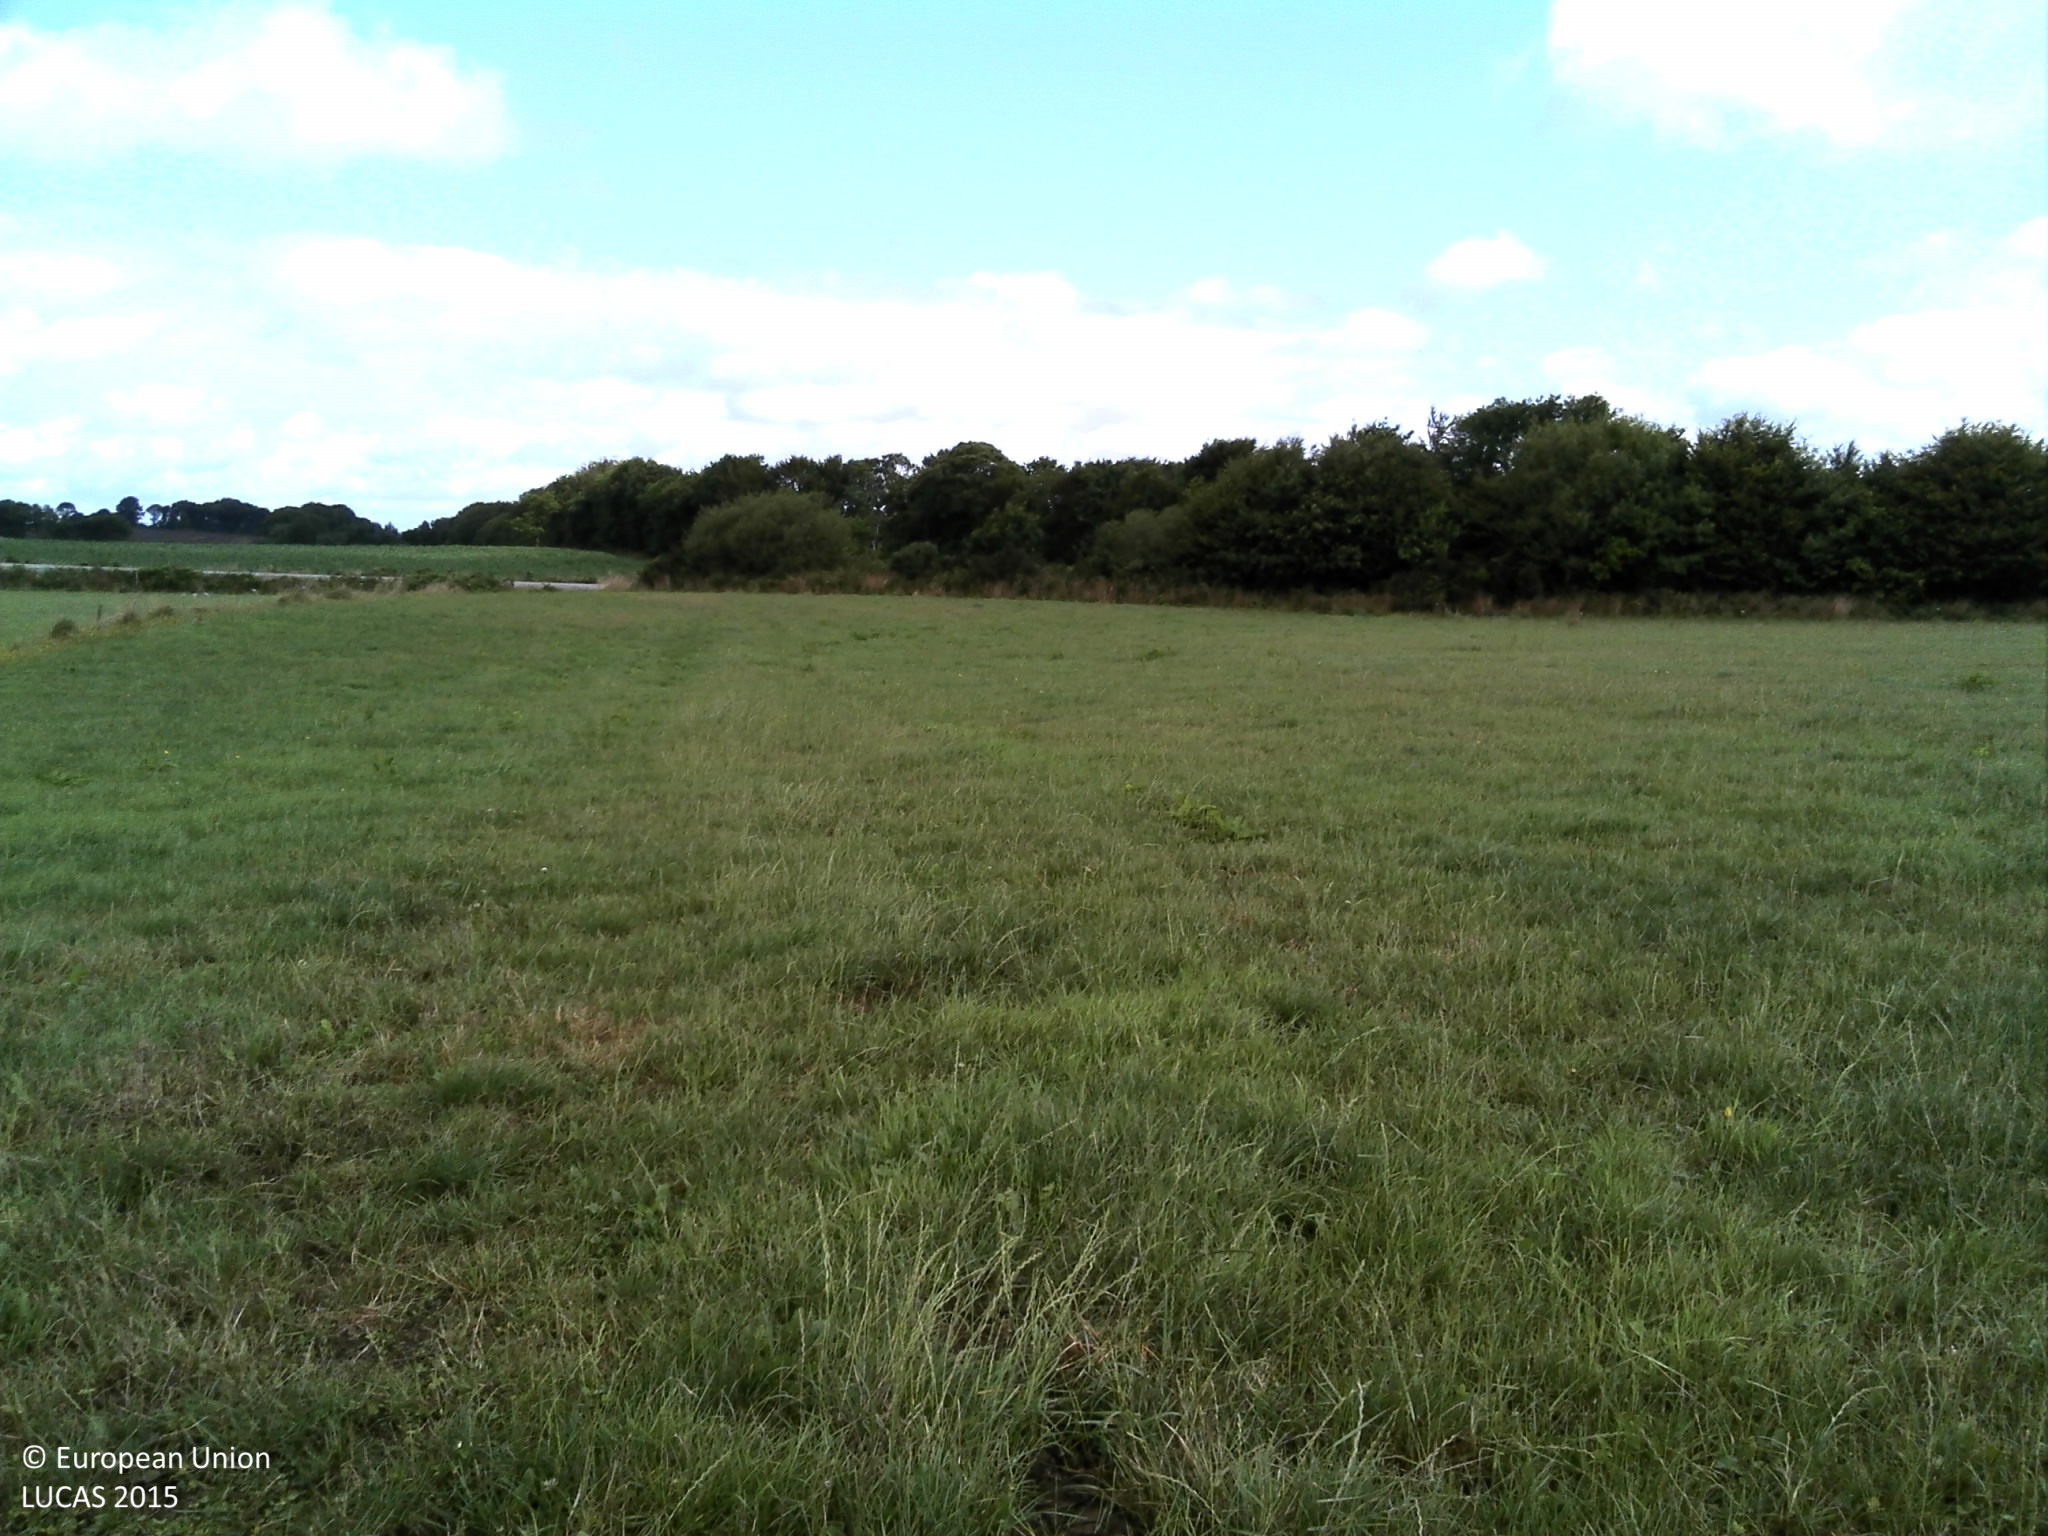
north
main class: Grassland
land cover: Grassland without tree/shrub cover
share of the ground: > 75 %
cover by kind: herbaceous plants 100 %
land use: Agriculture (excluding fallow land and kitchen gardens)
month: July
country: FR
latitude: 48.0943
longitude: -4.1204
